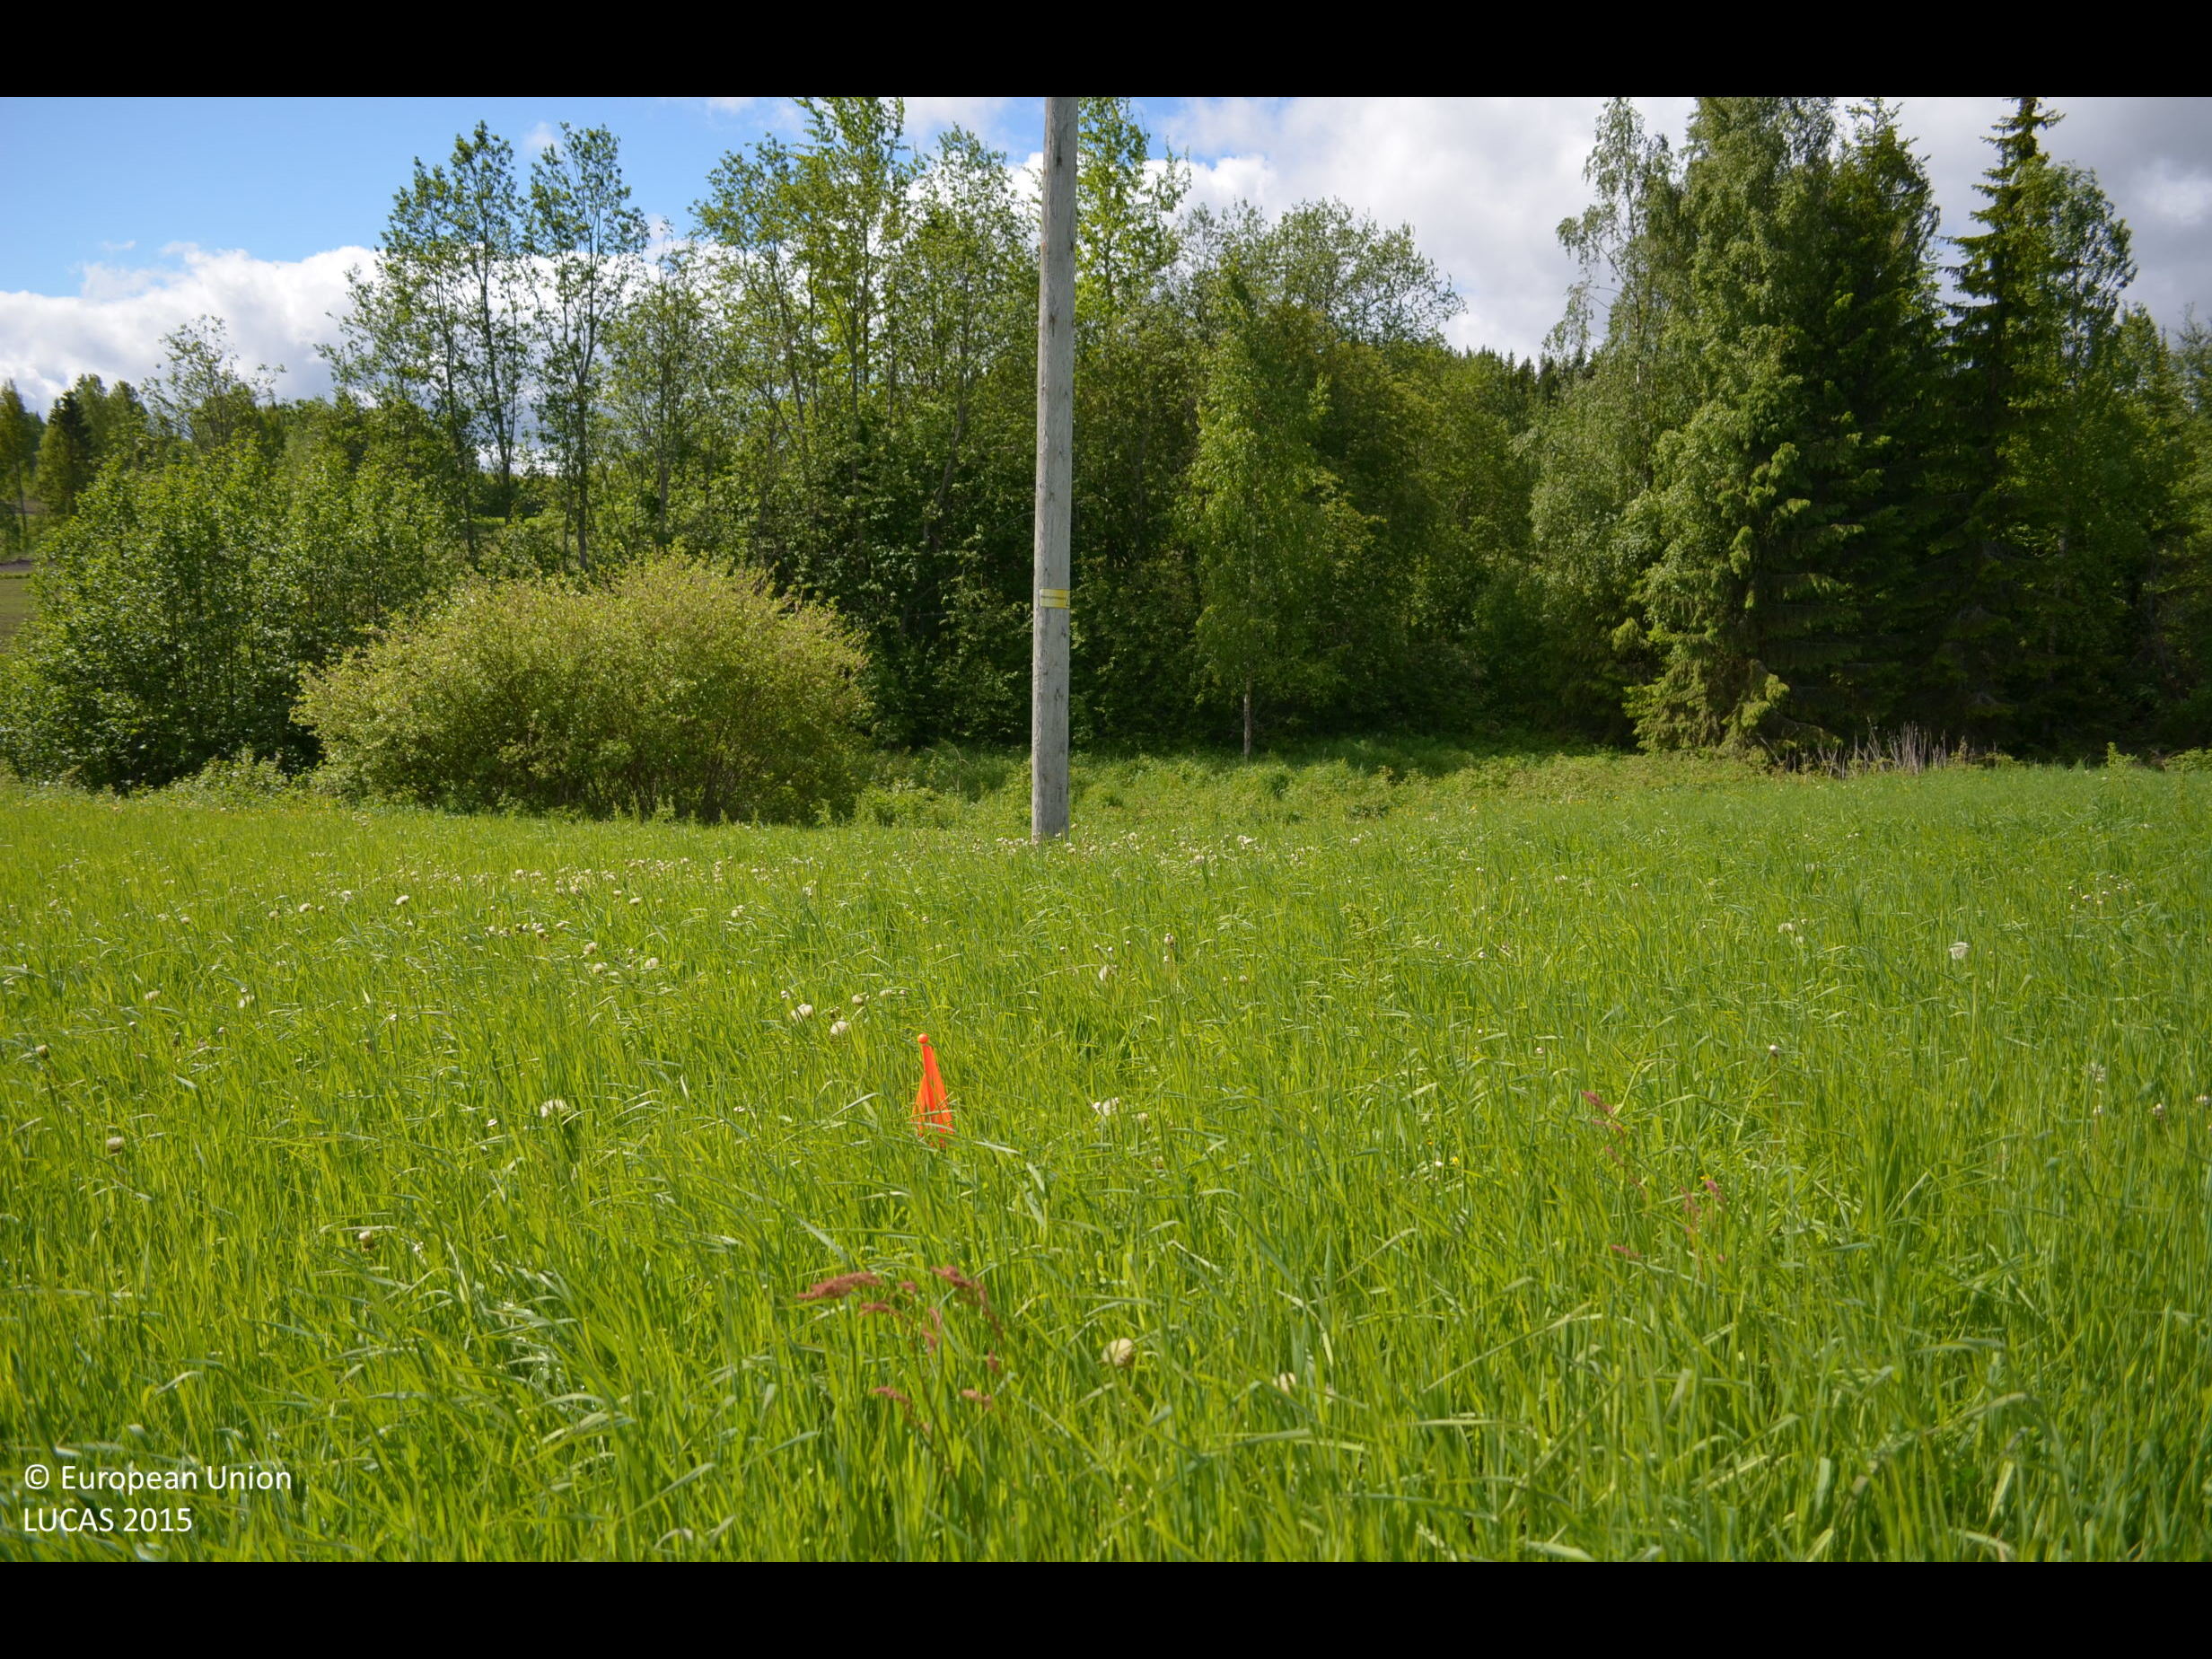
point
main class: Cropland
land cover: Temporary grasslands
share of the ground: > 75 %
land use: Agriculture (excluding fallow land and kitchen gardens)
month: June
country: FI
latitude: 61.8747
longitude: 22.8636
